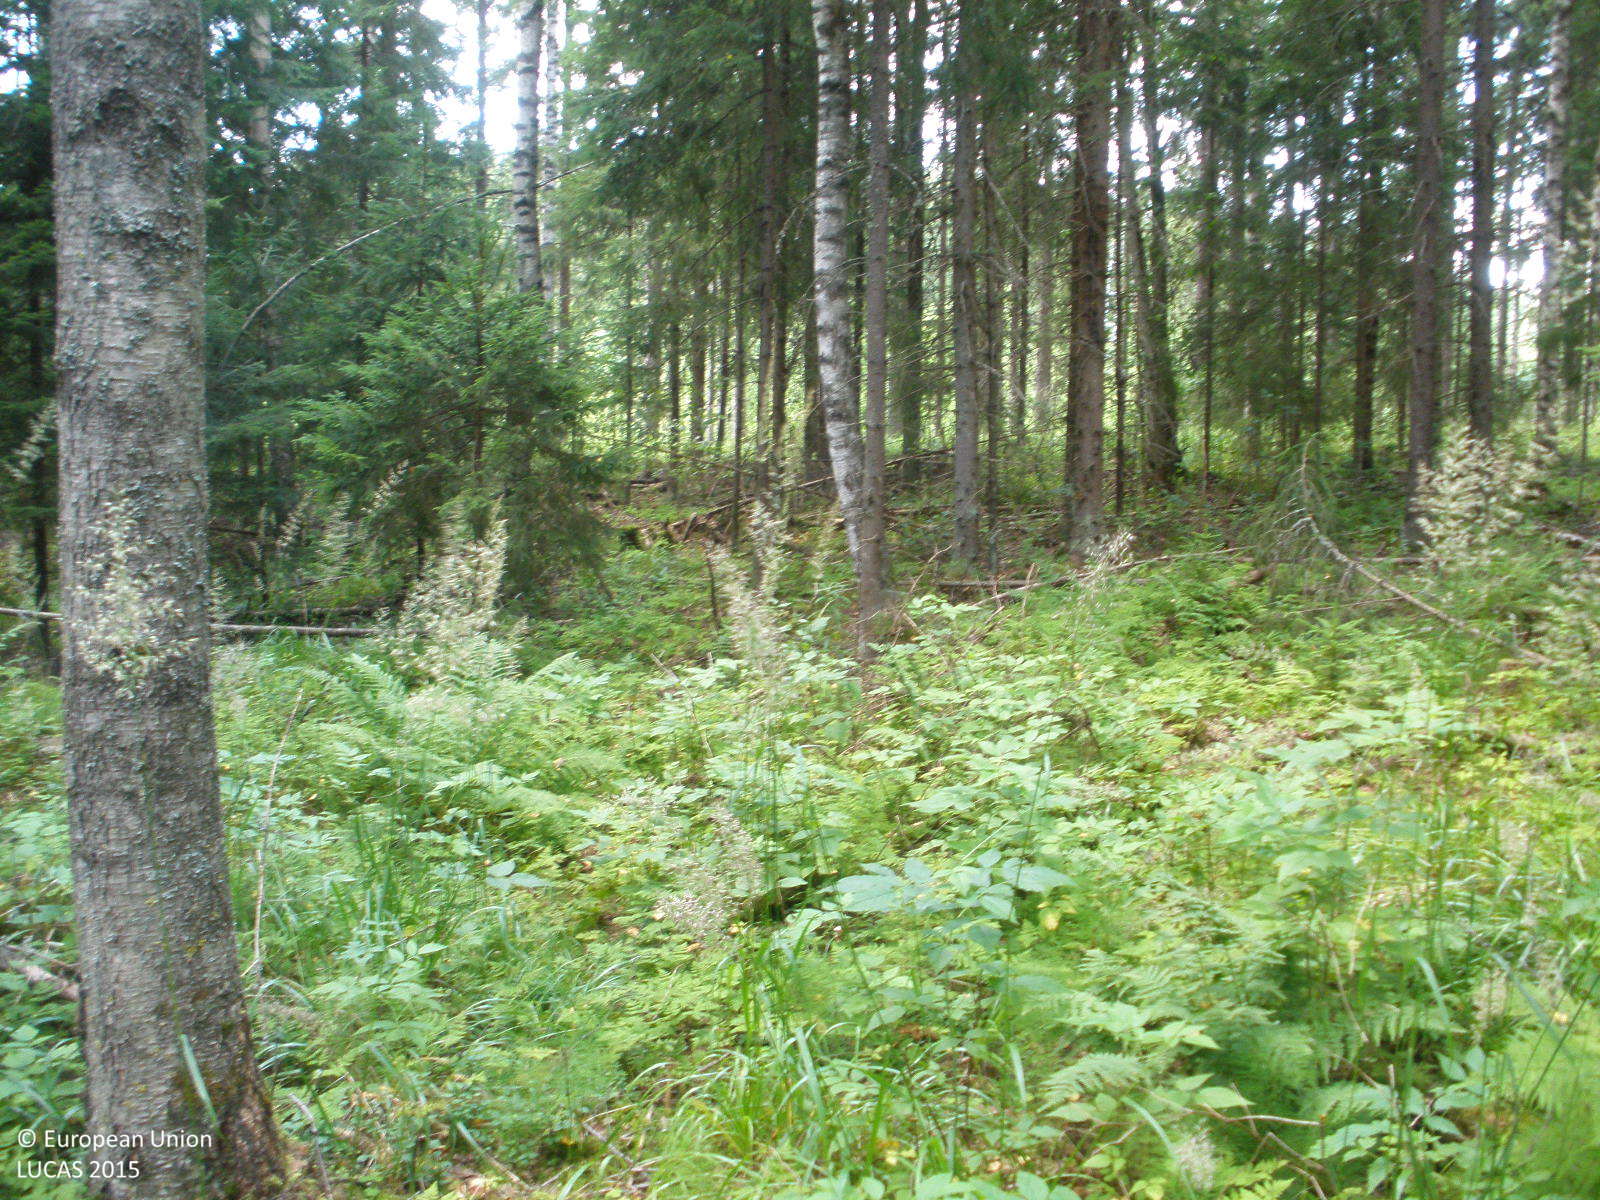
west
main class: Woodland
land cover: Spruce dominated mixed woodland
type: boreal forest
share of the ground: > 75 %
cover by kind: broadleaved forest trees 55 %, coniferous forest trees 30 %, herbaceous plants 10 %, lichens and mosses 5 %
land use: Forestry
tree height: > 5 m
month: August
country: FI
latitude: 61.0027
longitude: 24.6973
